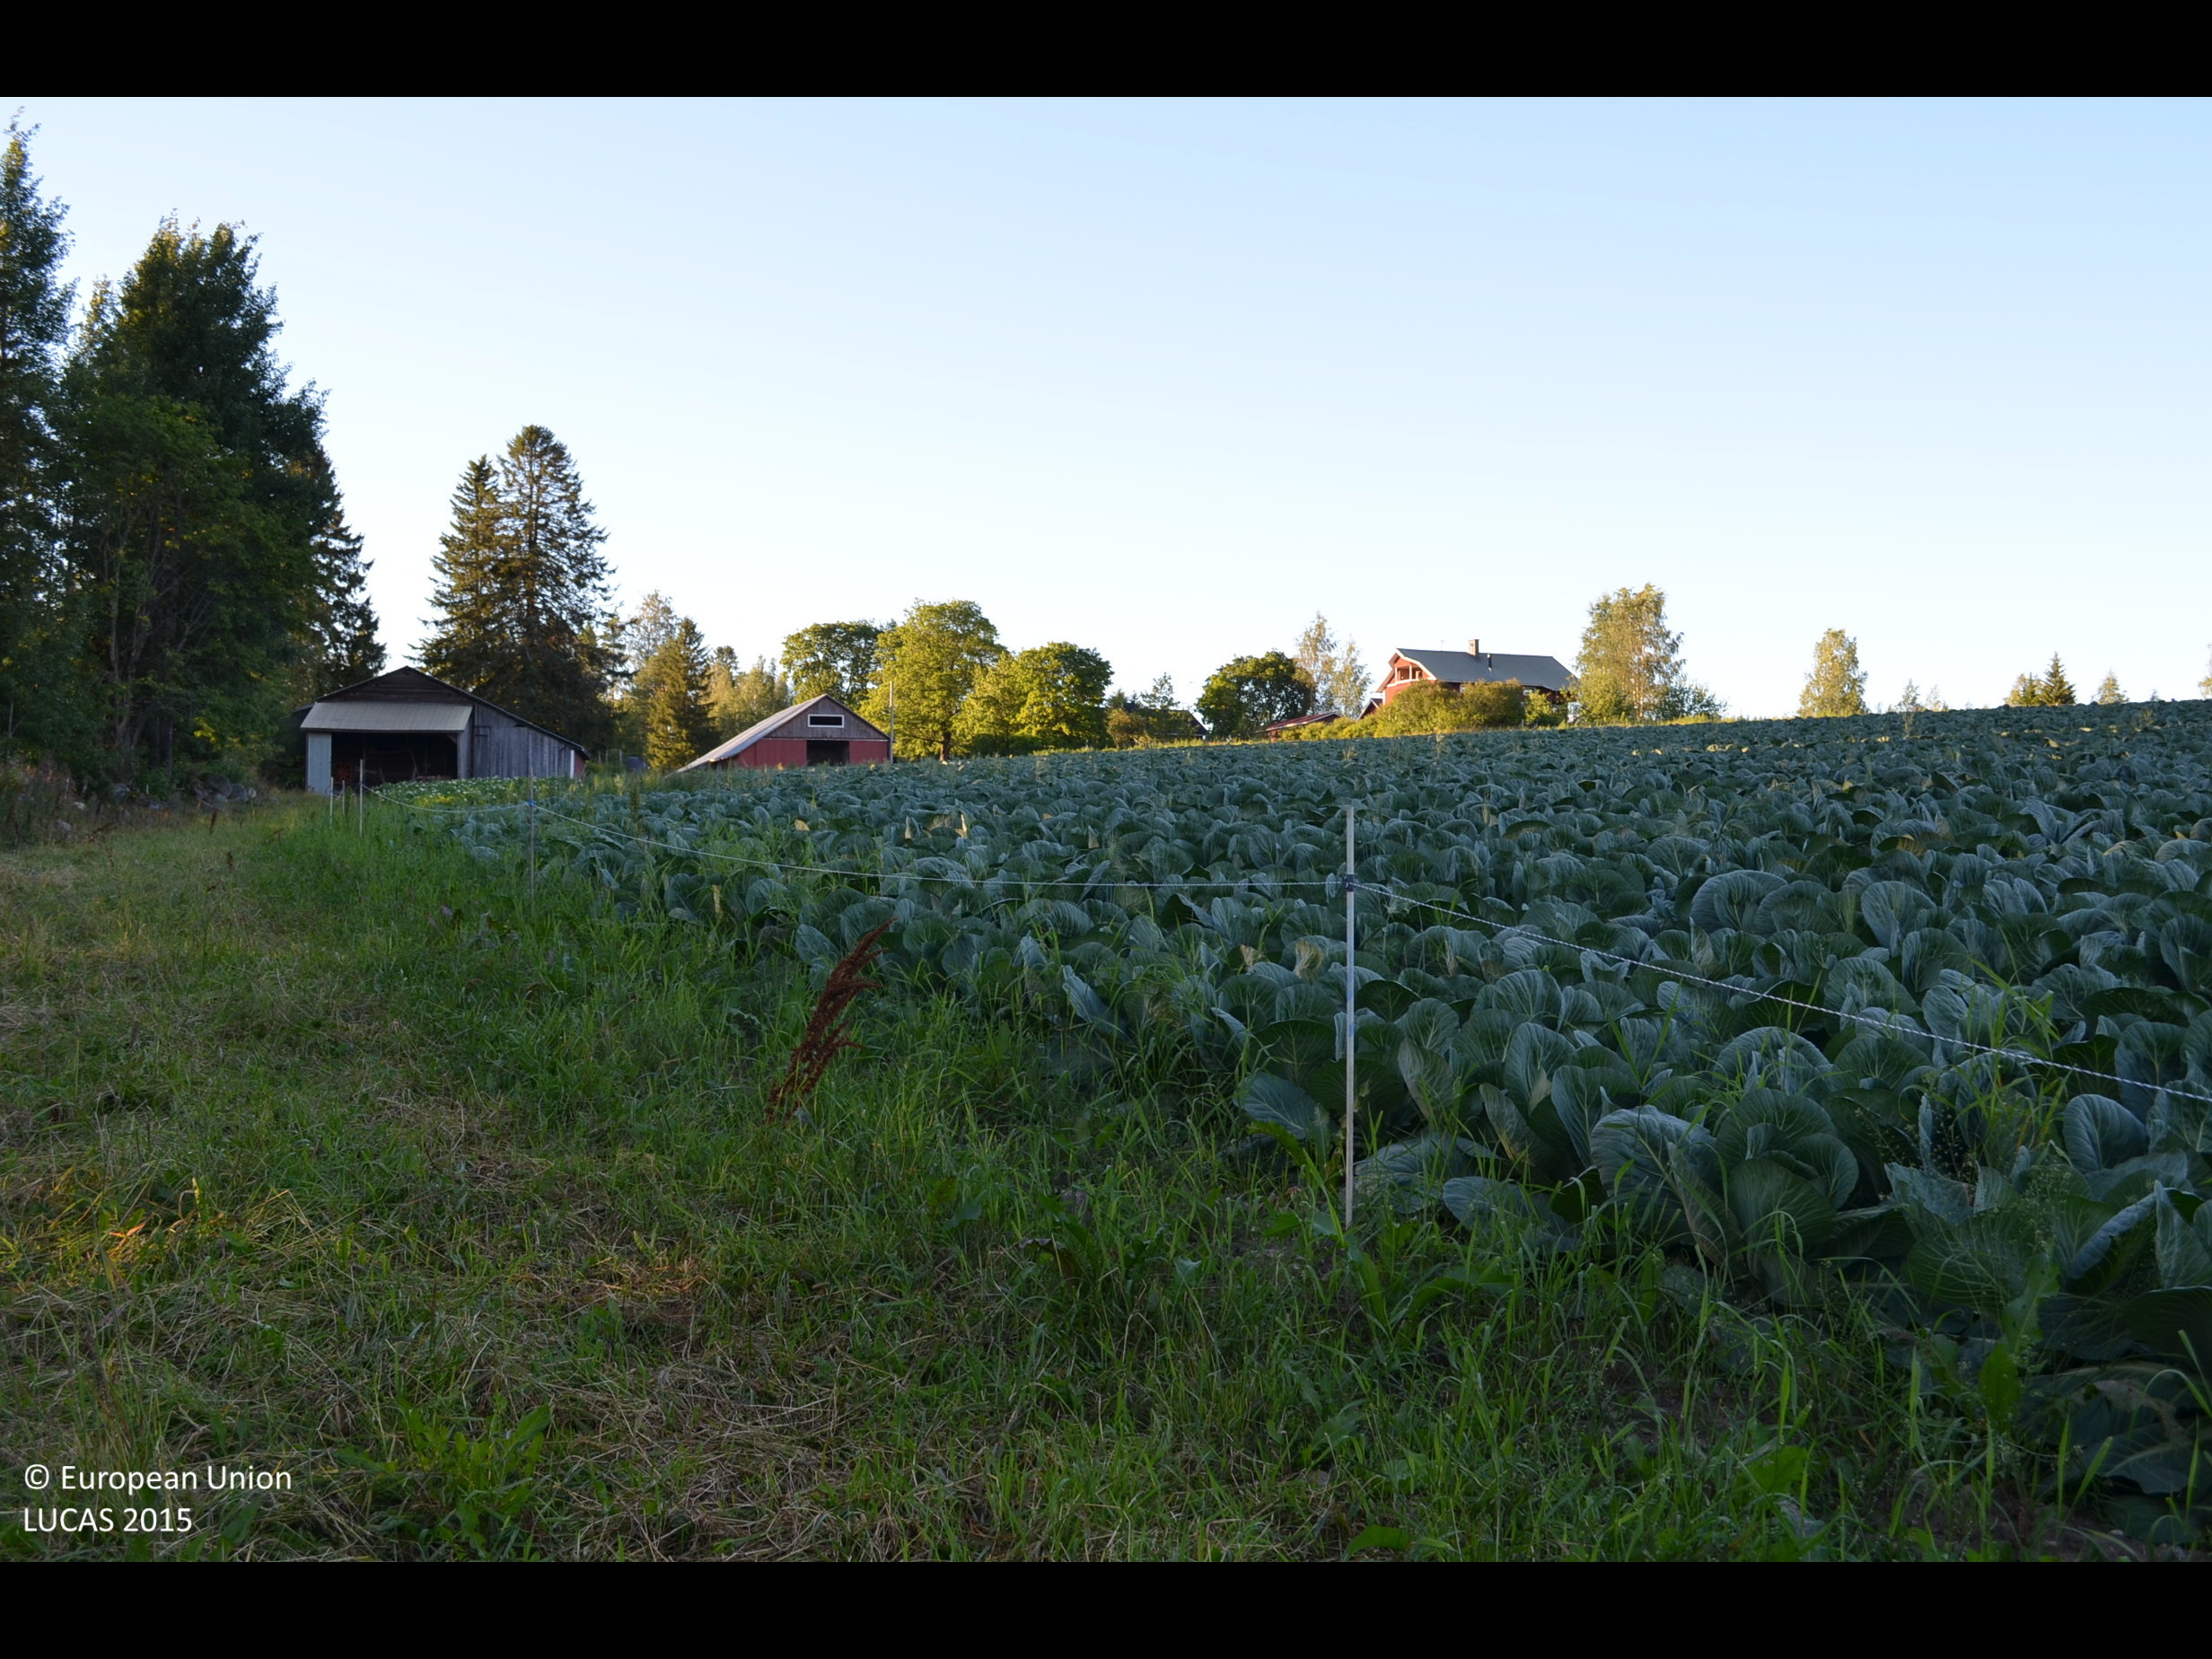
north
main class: Cropland
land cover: Temporary grasslands
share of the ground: > 75 %
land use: Agriculture (excluding fallow land and kitchen gardens)
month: August
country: FI
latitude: 62.3068
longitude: 24.3421
